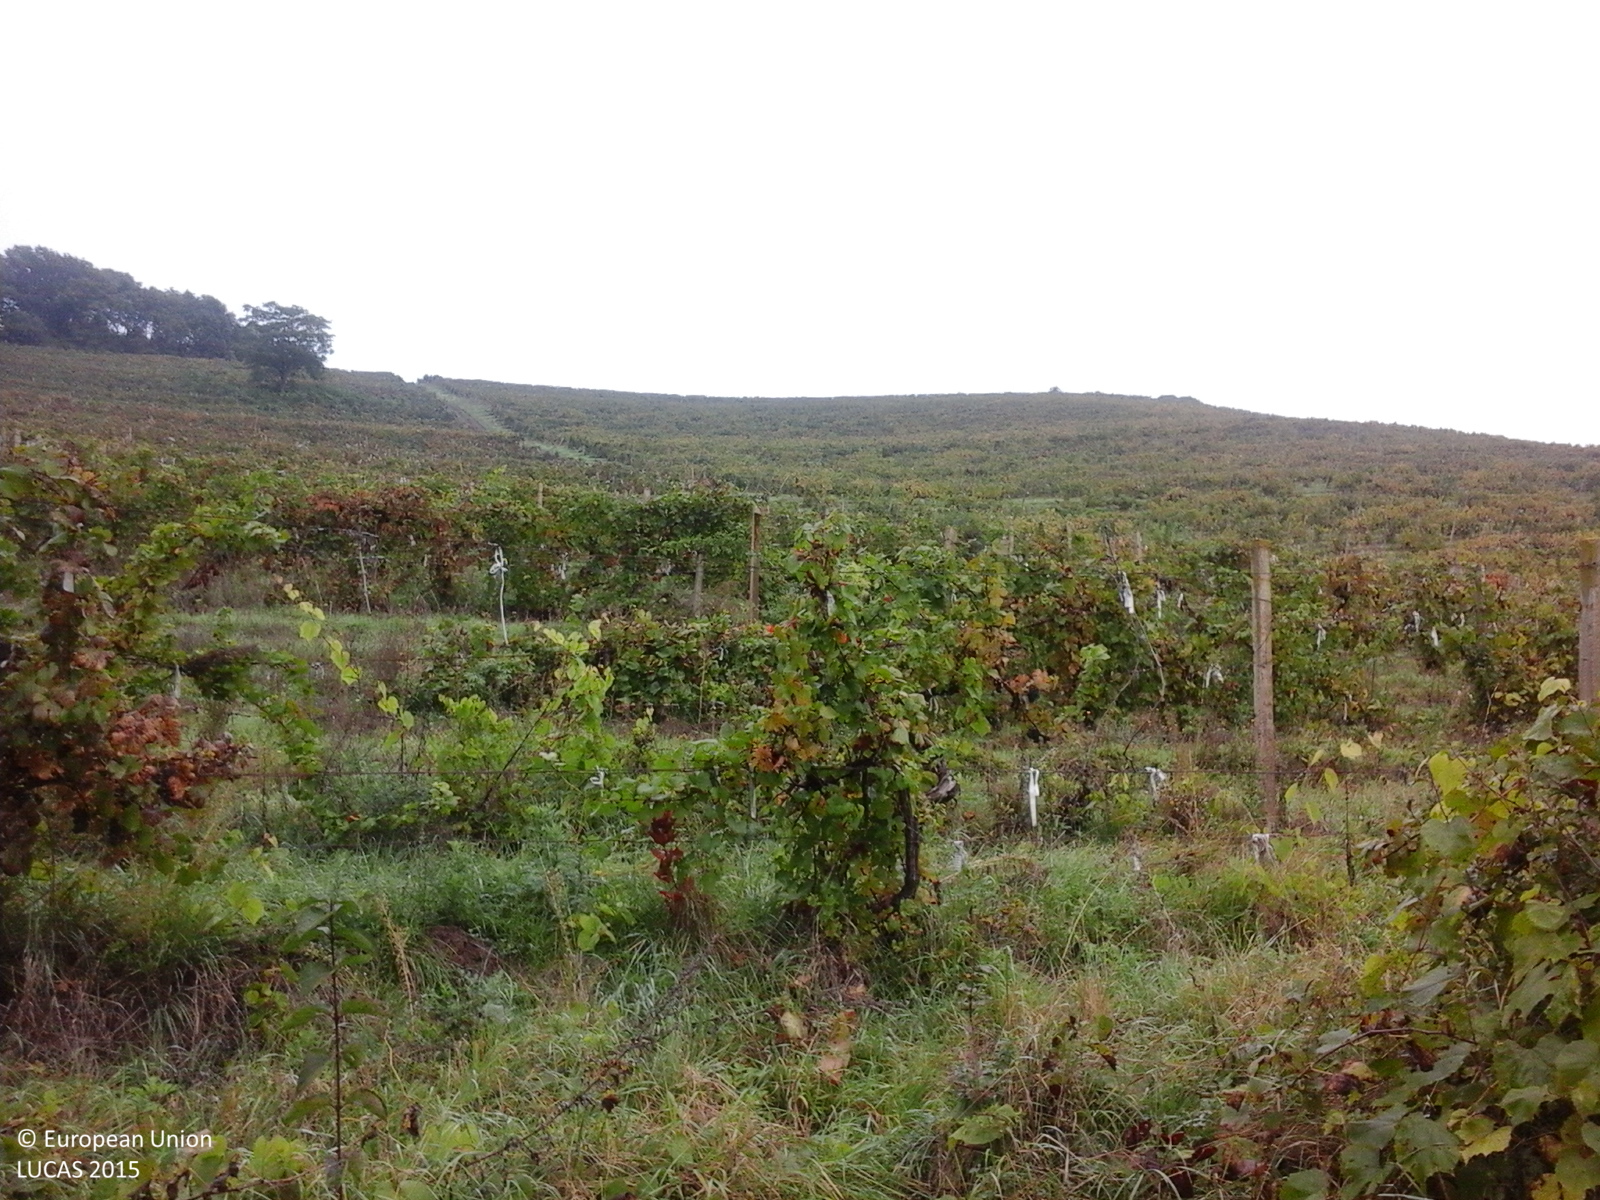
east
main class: Shrubland
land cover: Shrubland with sparse tree cover
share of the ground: > 75 %
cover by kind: shrubs 95 %, broadleaved forest trees 5 %
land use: Semi-natural and natural areas not in use
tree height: > 5 m
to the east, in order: Shrubland with sparse tree cover; Vineyards; Tracks; Vineyards
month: October
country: RO
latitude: 46.6478
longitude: 24.4191
